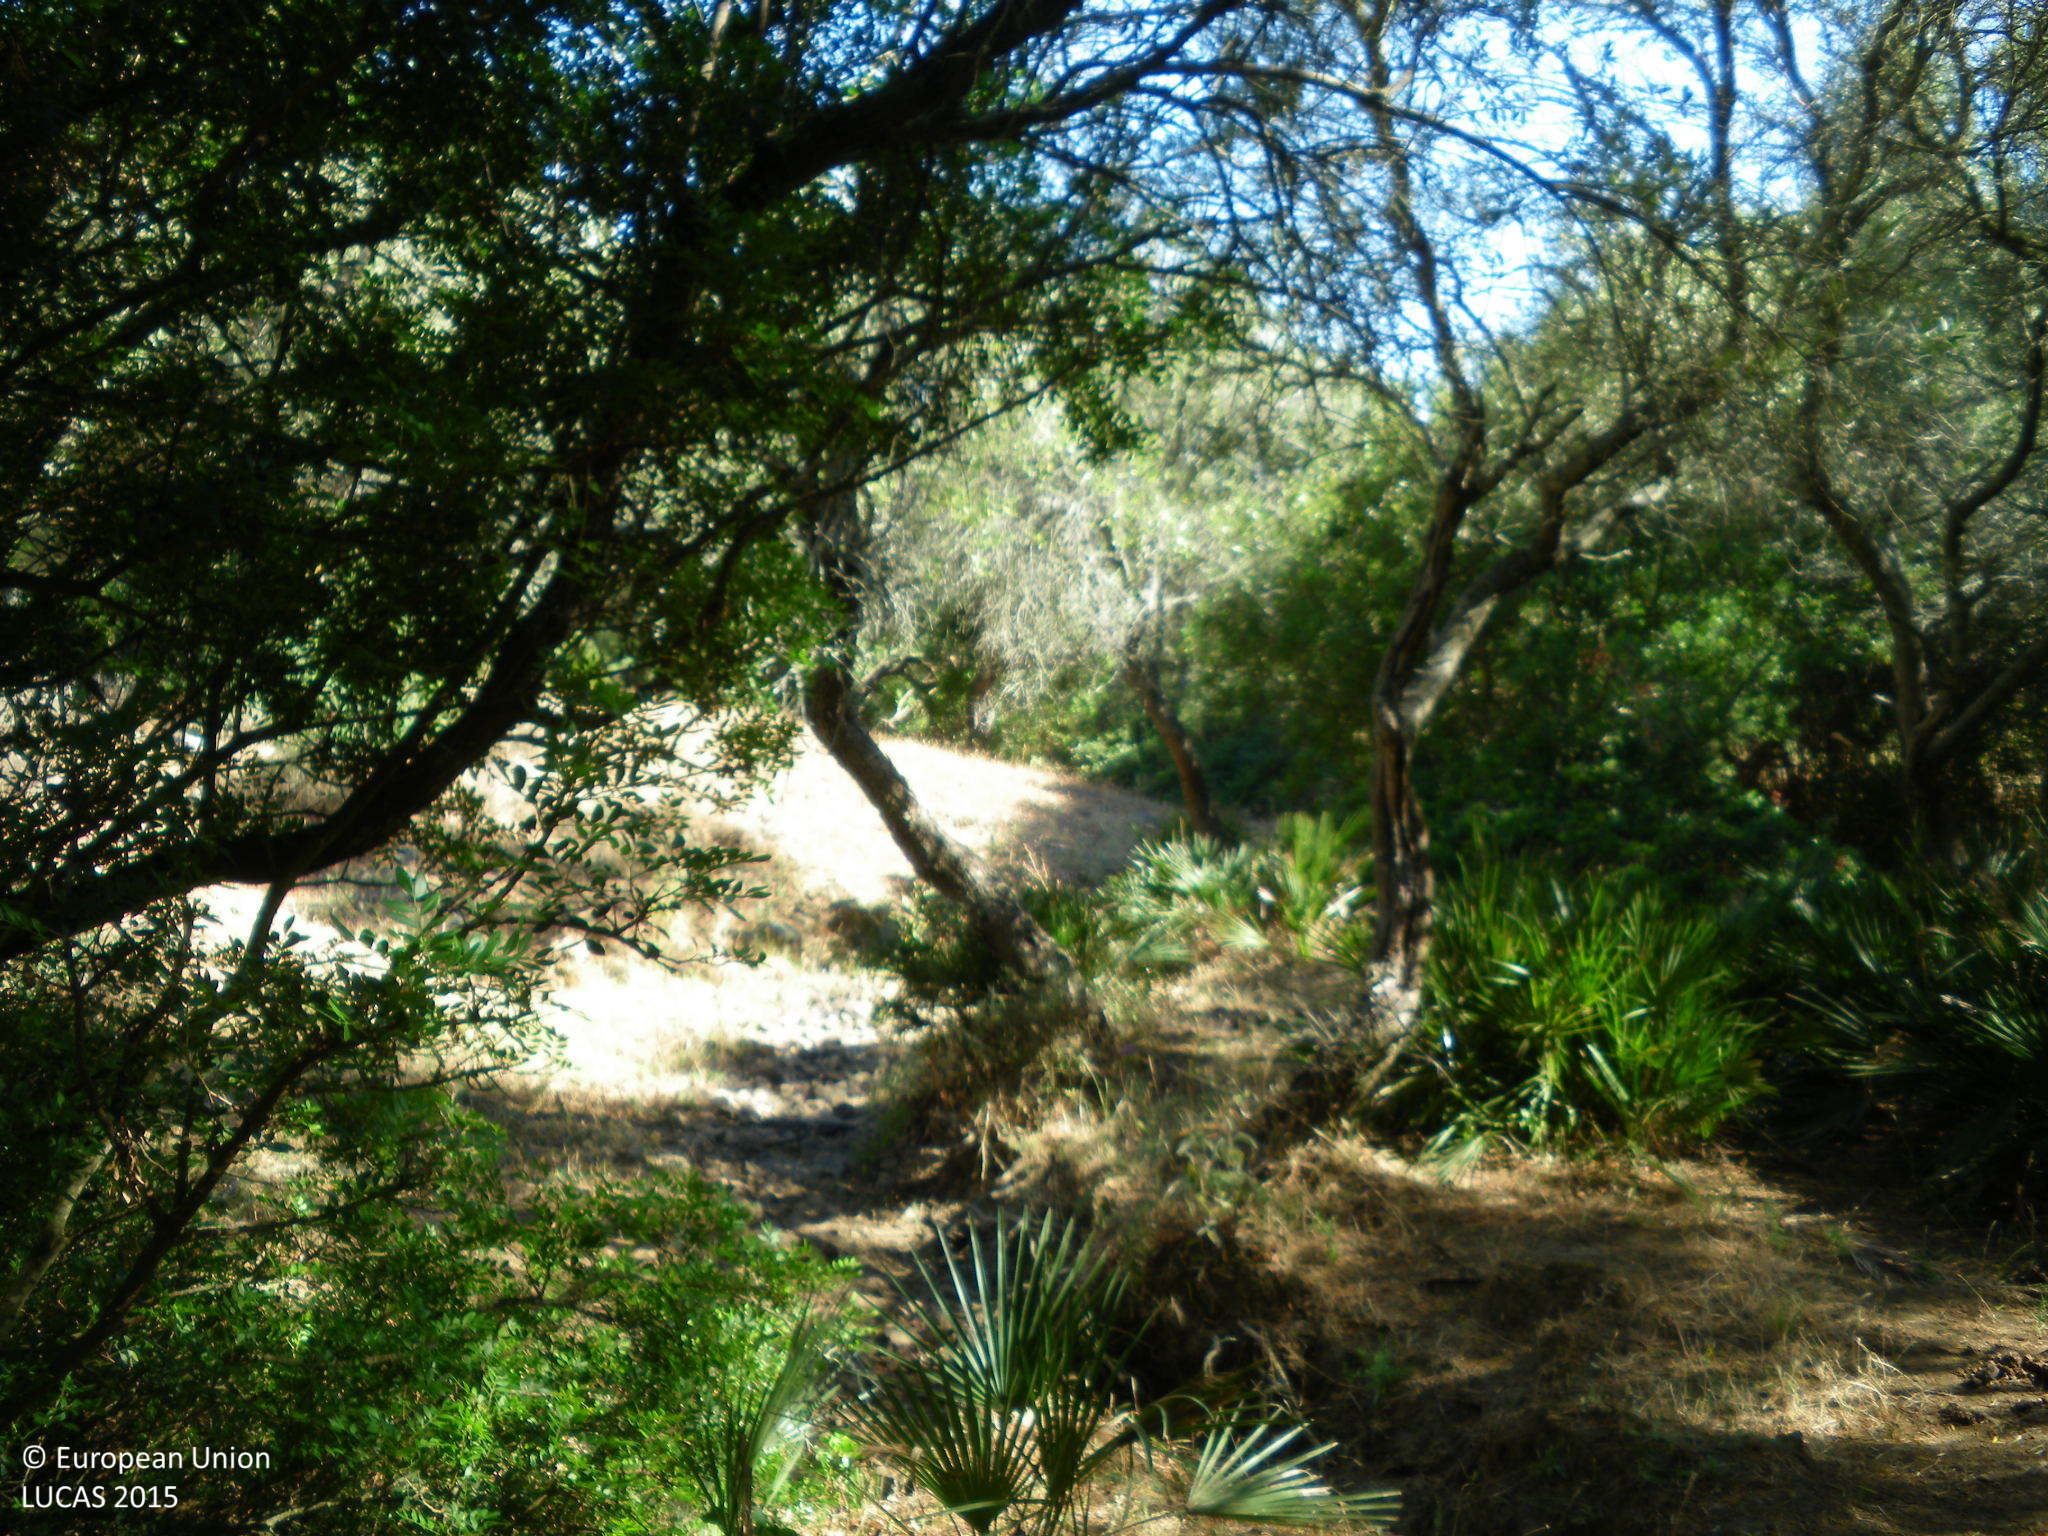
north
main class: Woodland
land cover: Broadleaved woodland
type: broadleaved evergreen forest
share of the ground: > 75 %
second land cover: Shrubland without tree cover
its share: 50 - 75 %
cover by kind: broadleaved forest trees 75 %, herbaceous plants 15 %, shrubs 5 %, unconsolidated bare surface 5 %
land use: Forestry
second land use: Agriculture (excluding fallow land and kitchen gardens)
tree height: > 5 m
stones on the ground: < 10 %
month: June
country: ES
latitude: 36.1252
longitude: -5.7844
